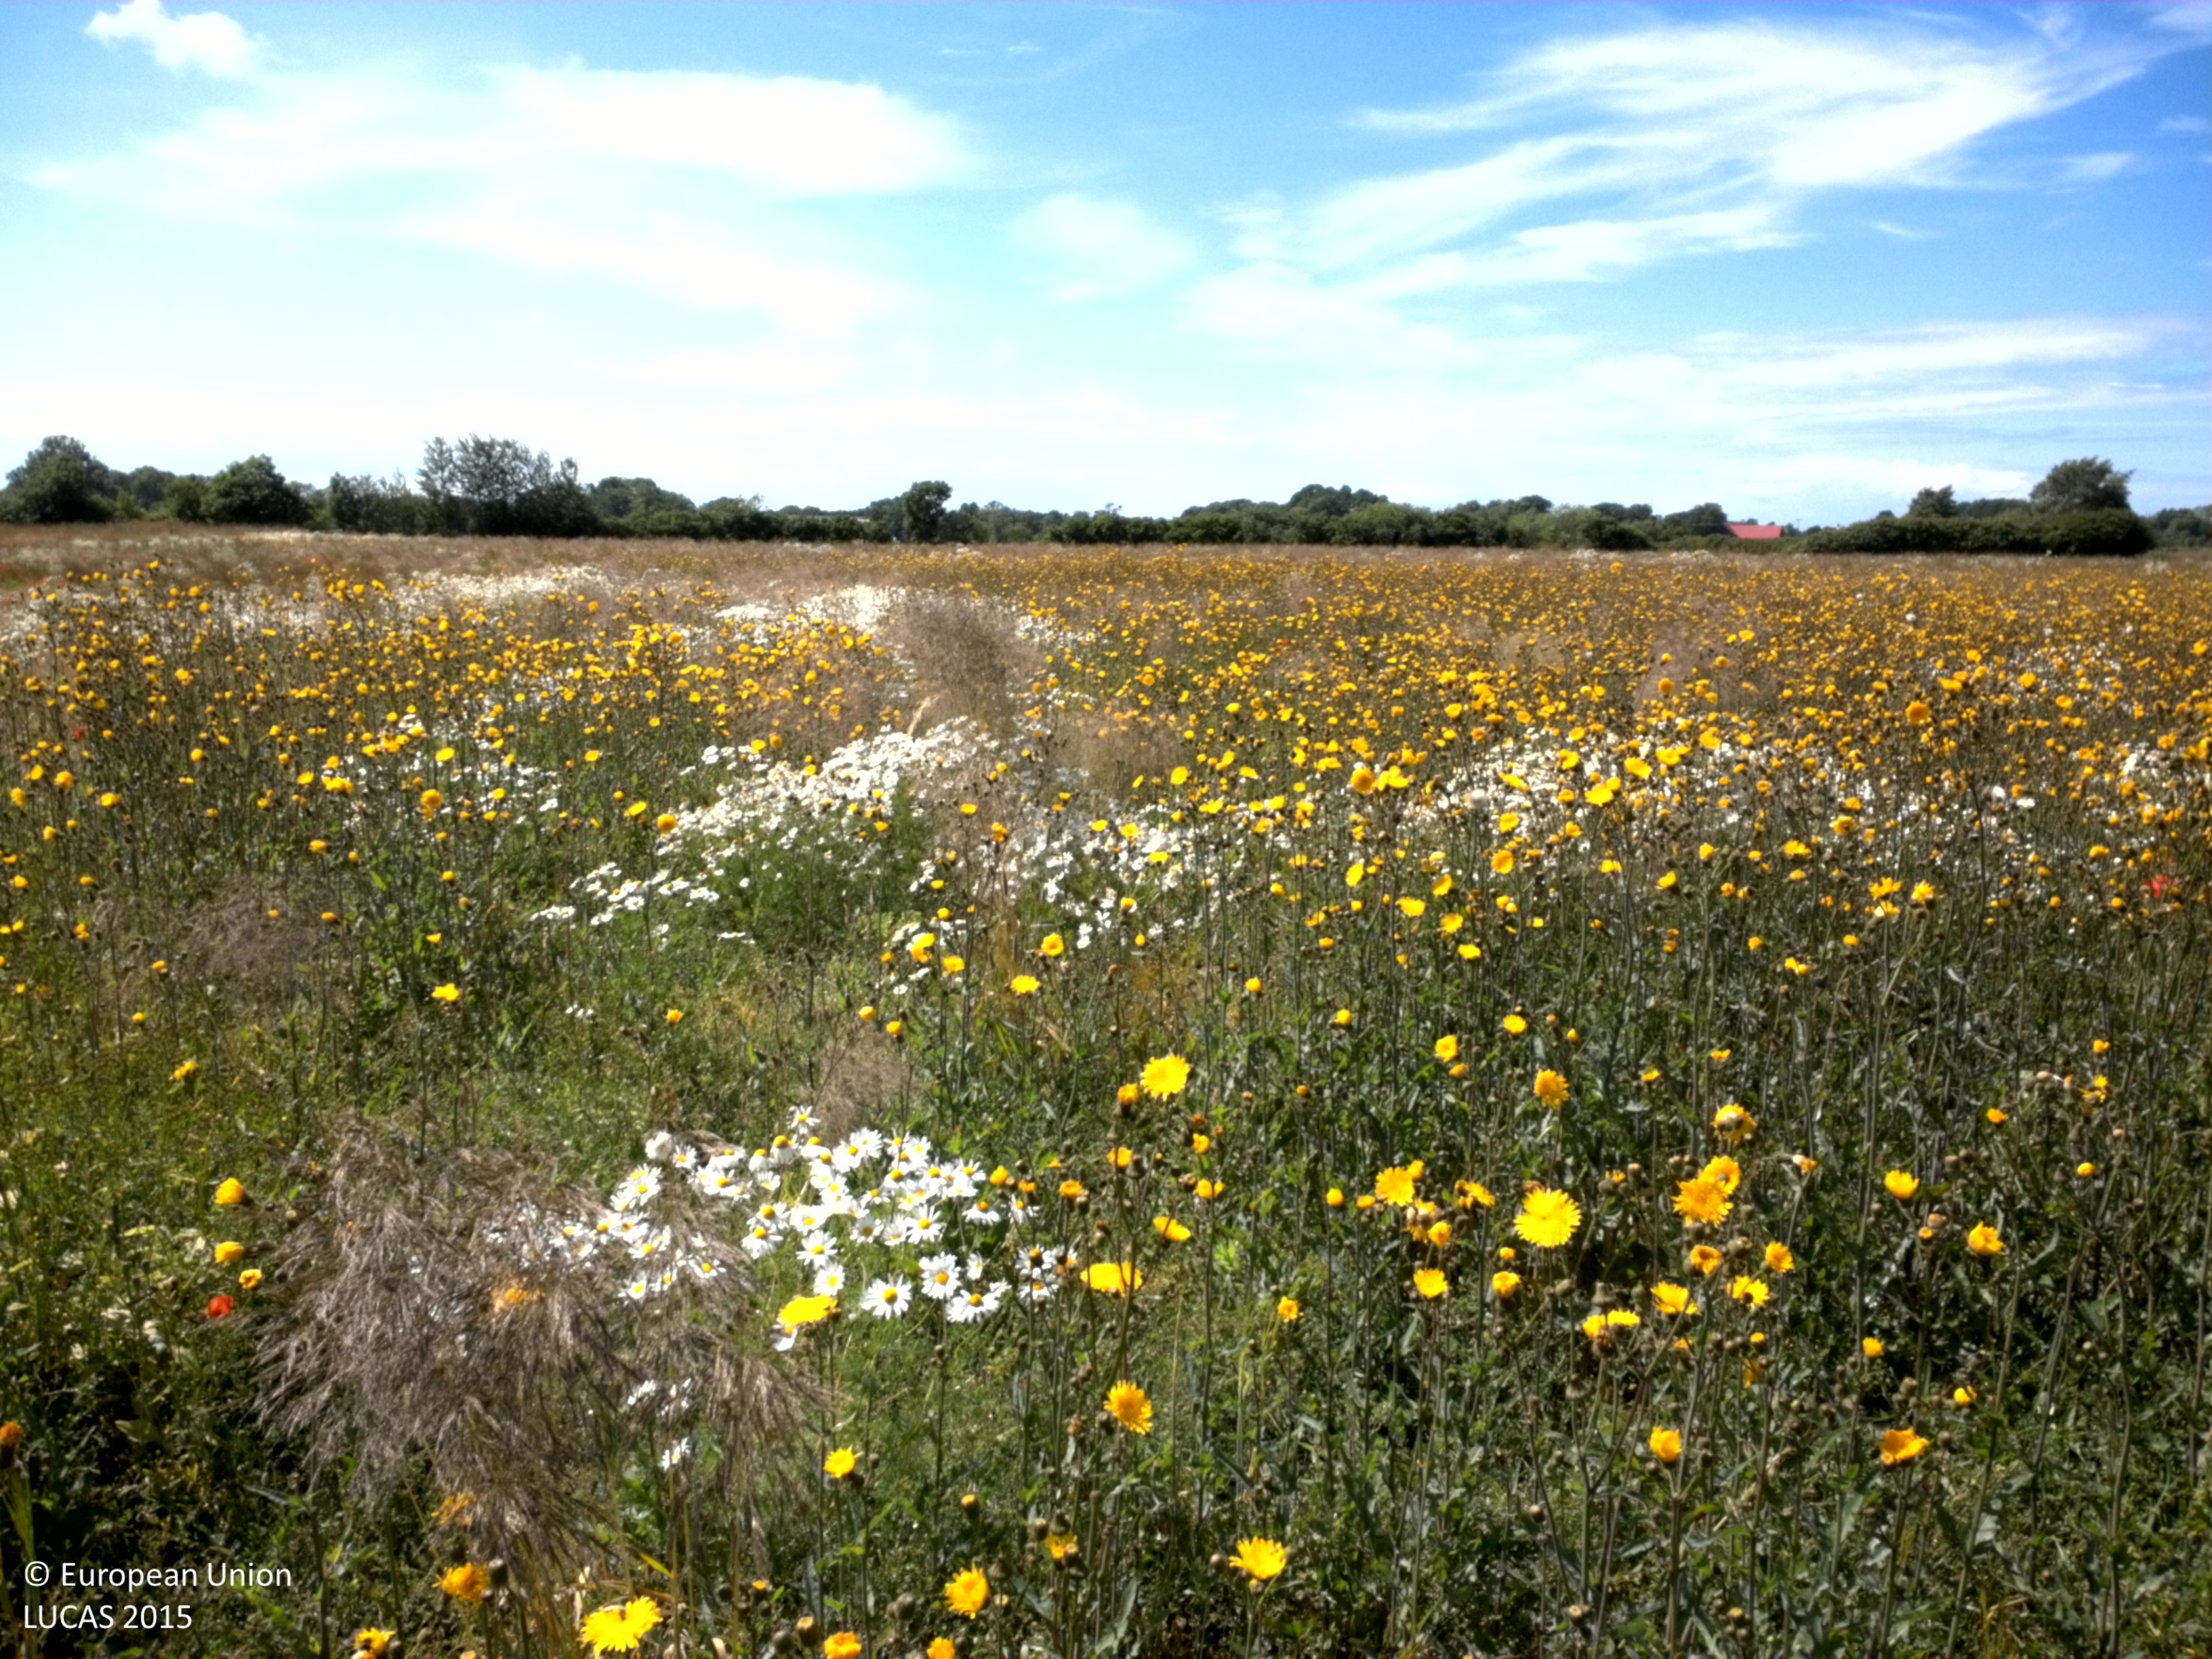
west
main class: Cropland
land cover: Temporary grasslands
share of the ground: > 75 %
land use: Agriculture (excluding fallow land and kitchen gardens)
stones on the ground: < 10 %
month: July
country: SE
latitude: 57.2823
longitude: 18.1856
